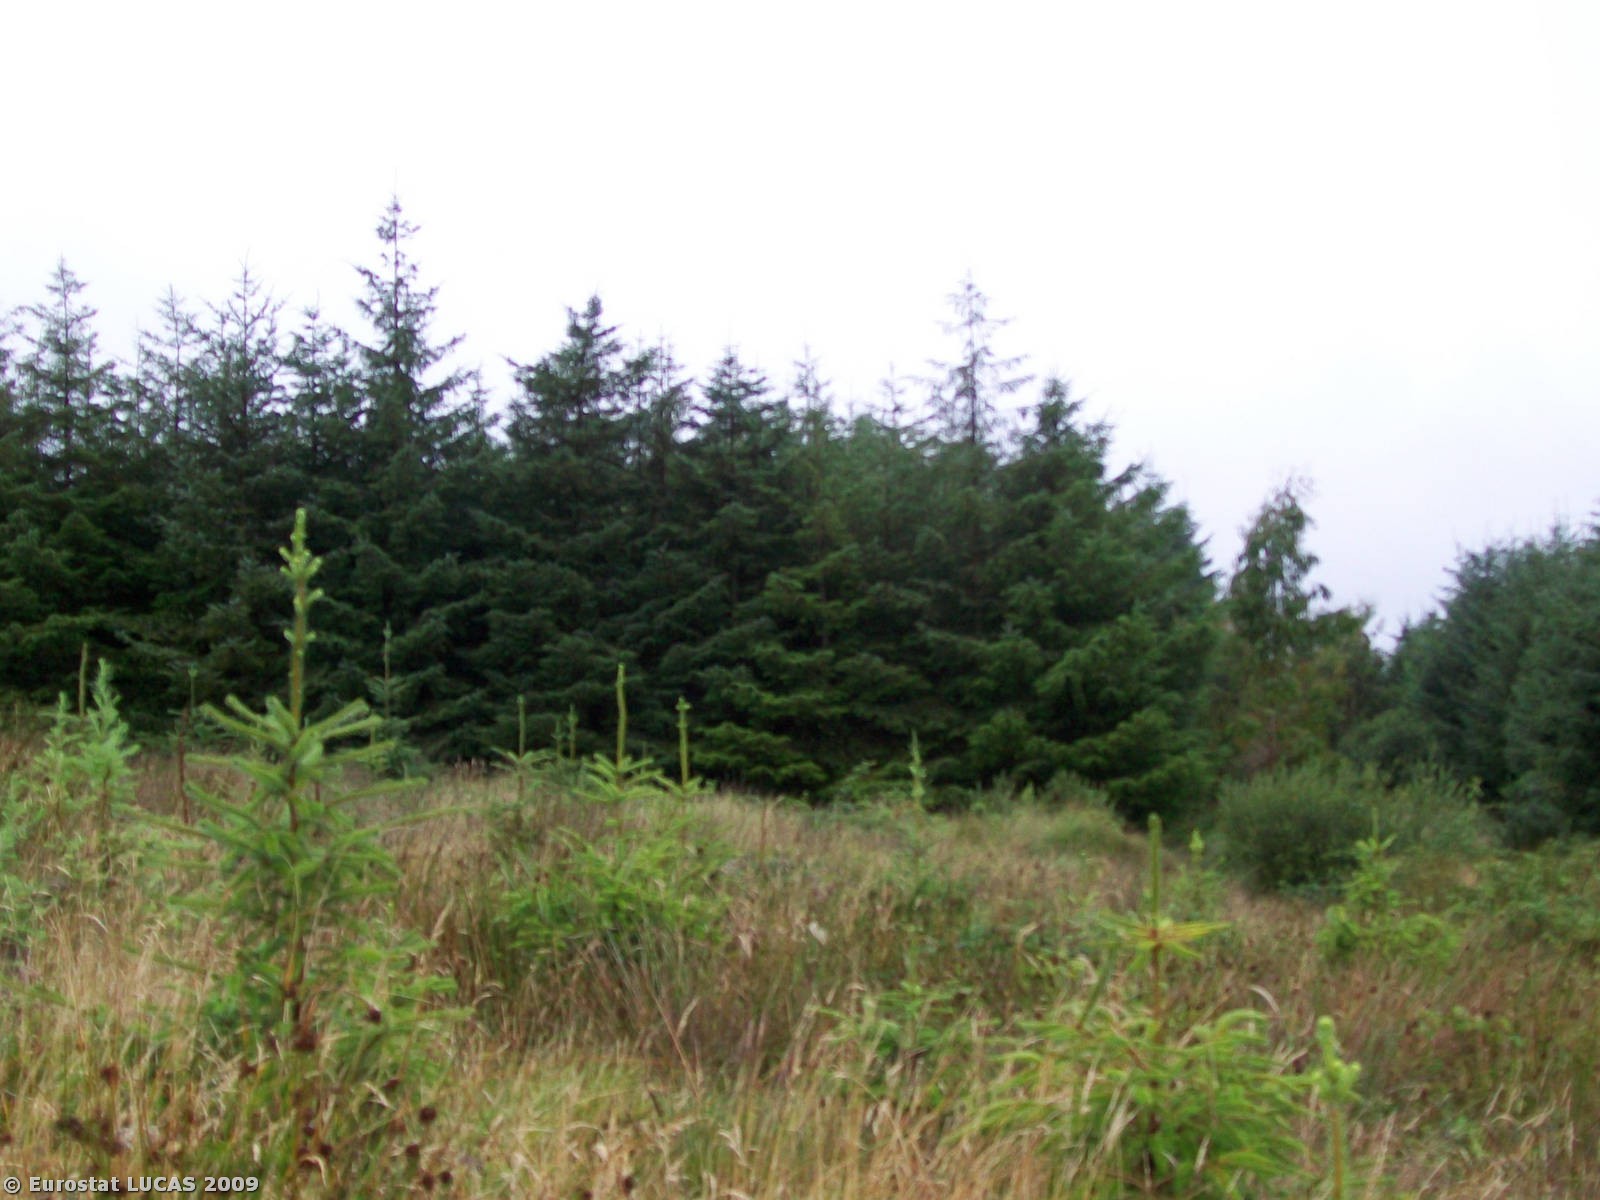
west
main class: Woodland
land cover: Coniferous woodland
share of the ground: > 75 %
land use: Forestry
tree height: < 5 m
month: August
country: IE
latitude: 52.7993
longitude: -9.1286
